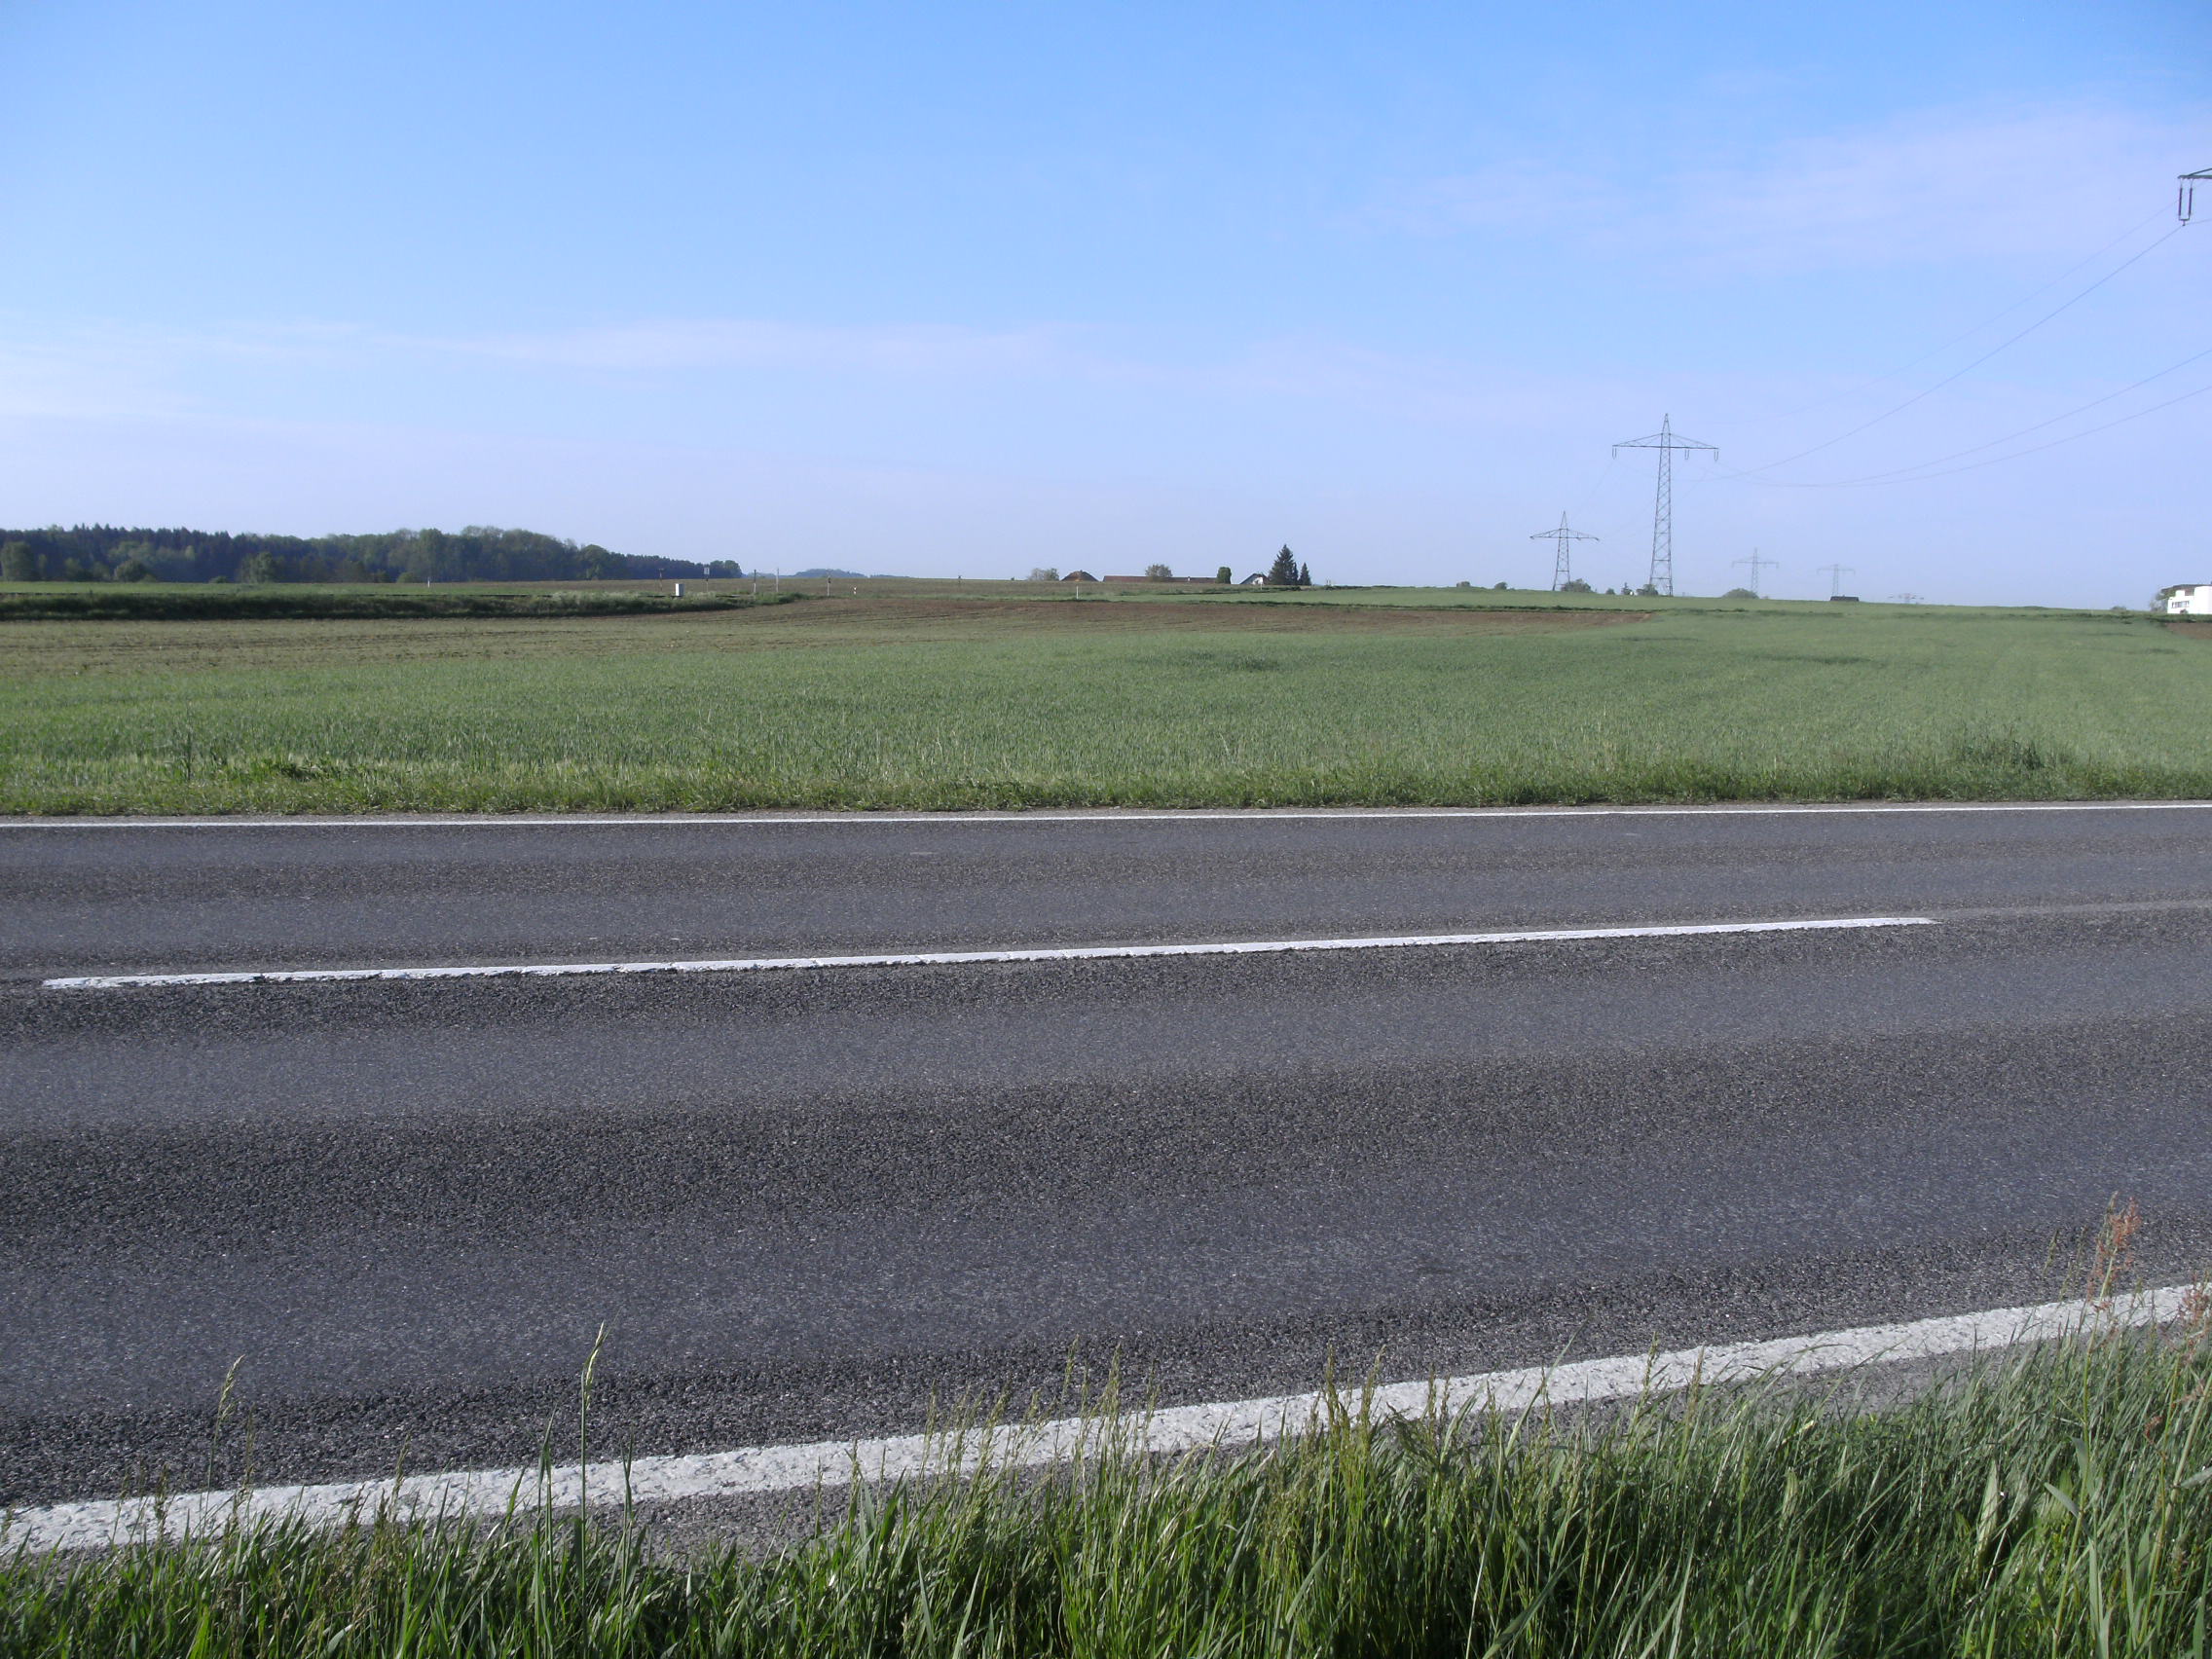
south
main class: Cropland
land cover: Barley
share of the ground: > 75 %
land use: Agriculture (excluding fallow land and kitchen gardens)
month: May
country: AT
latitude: 48.4219
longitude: 13.4452
